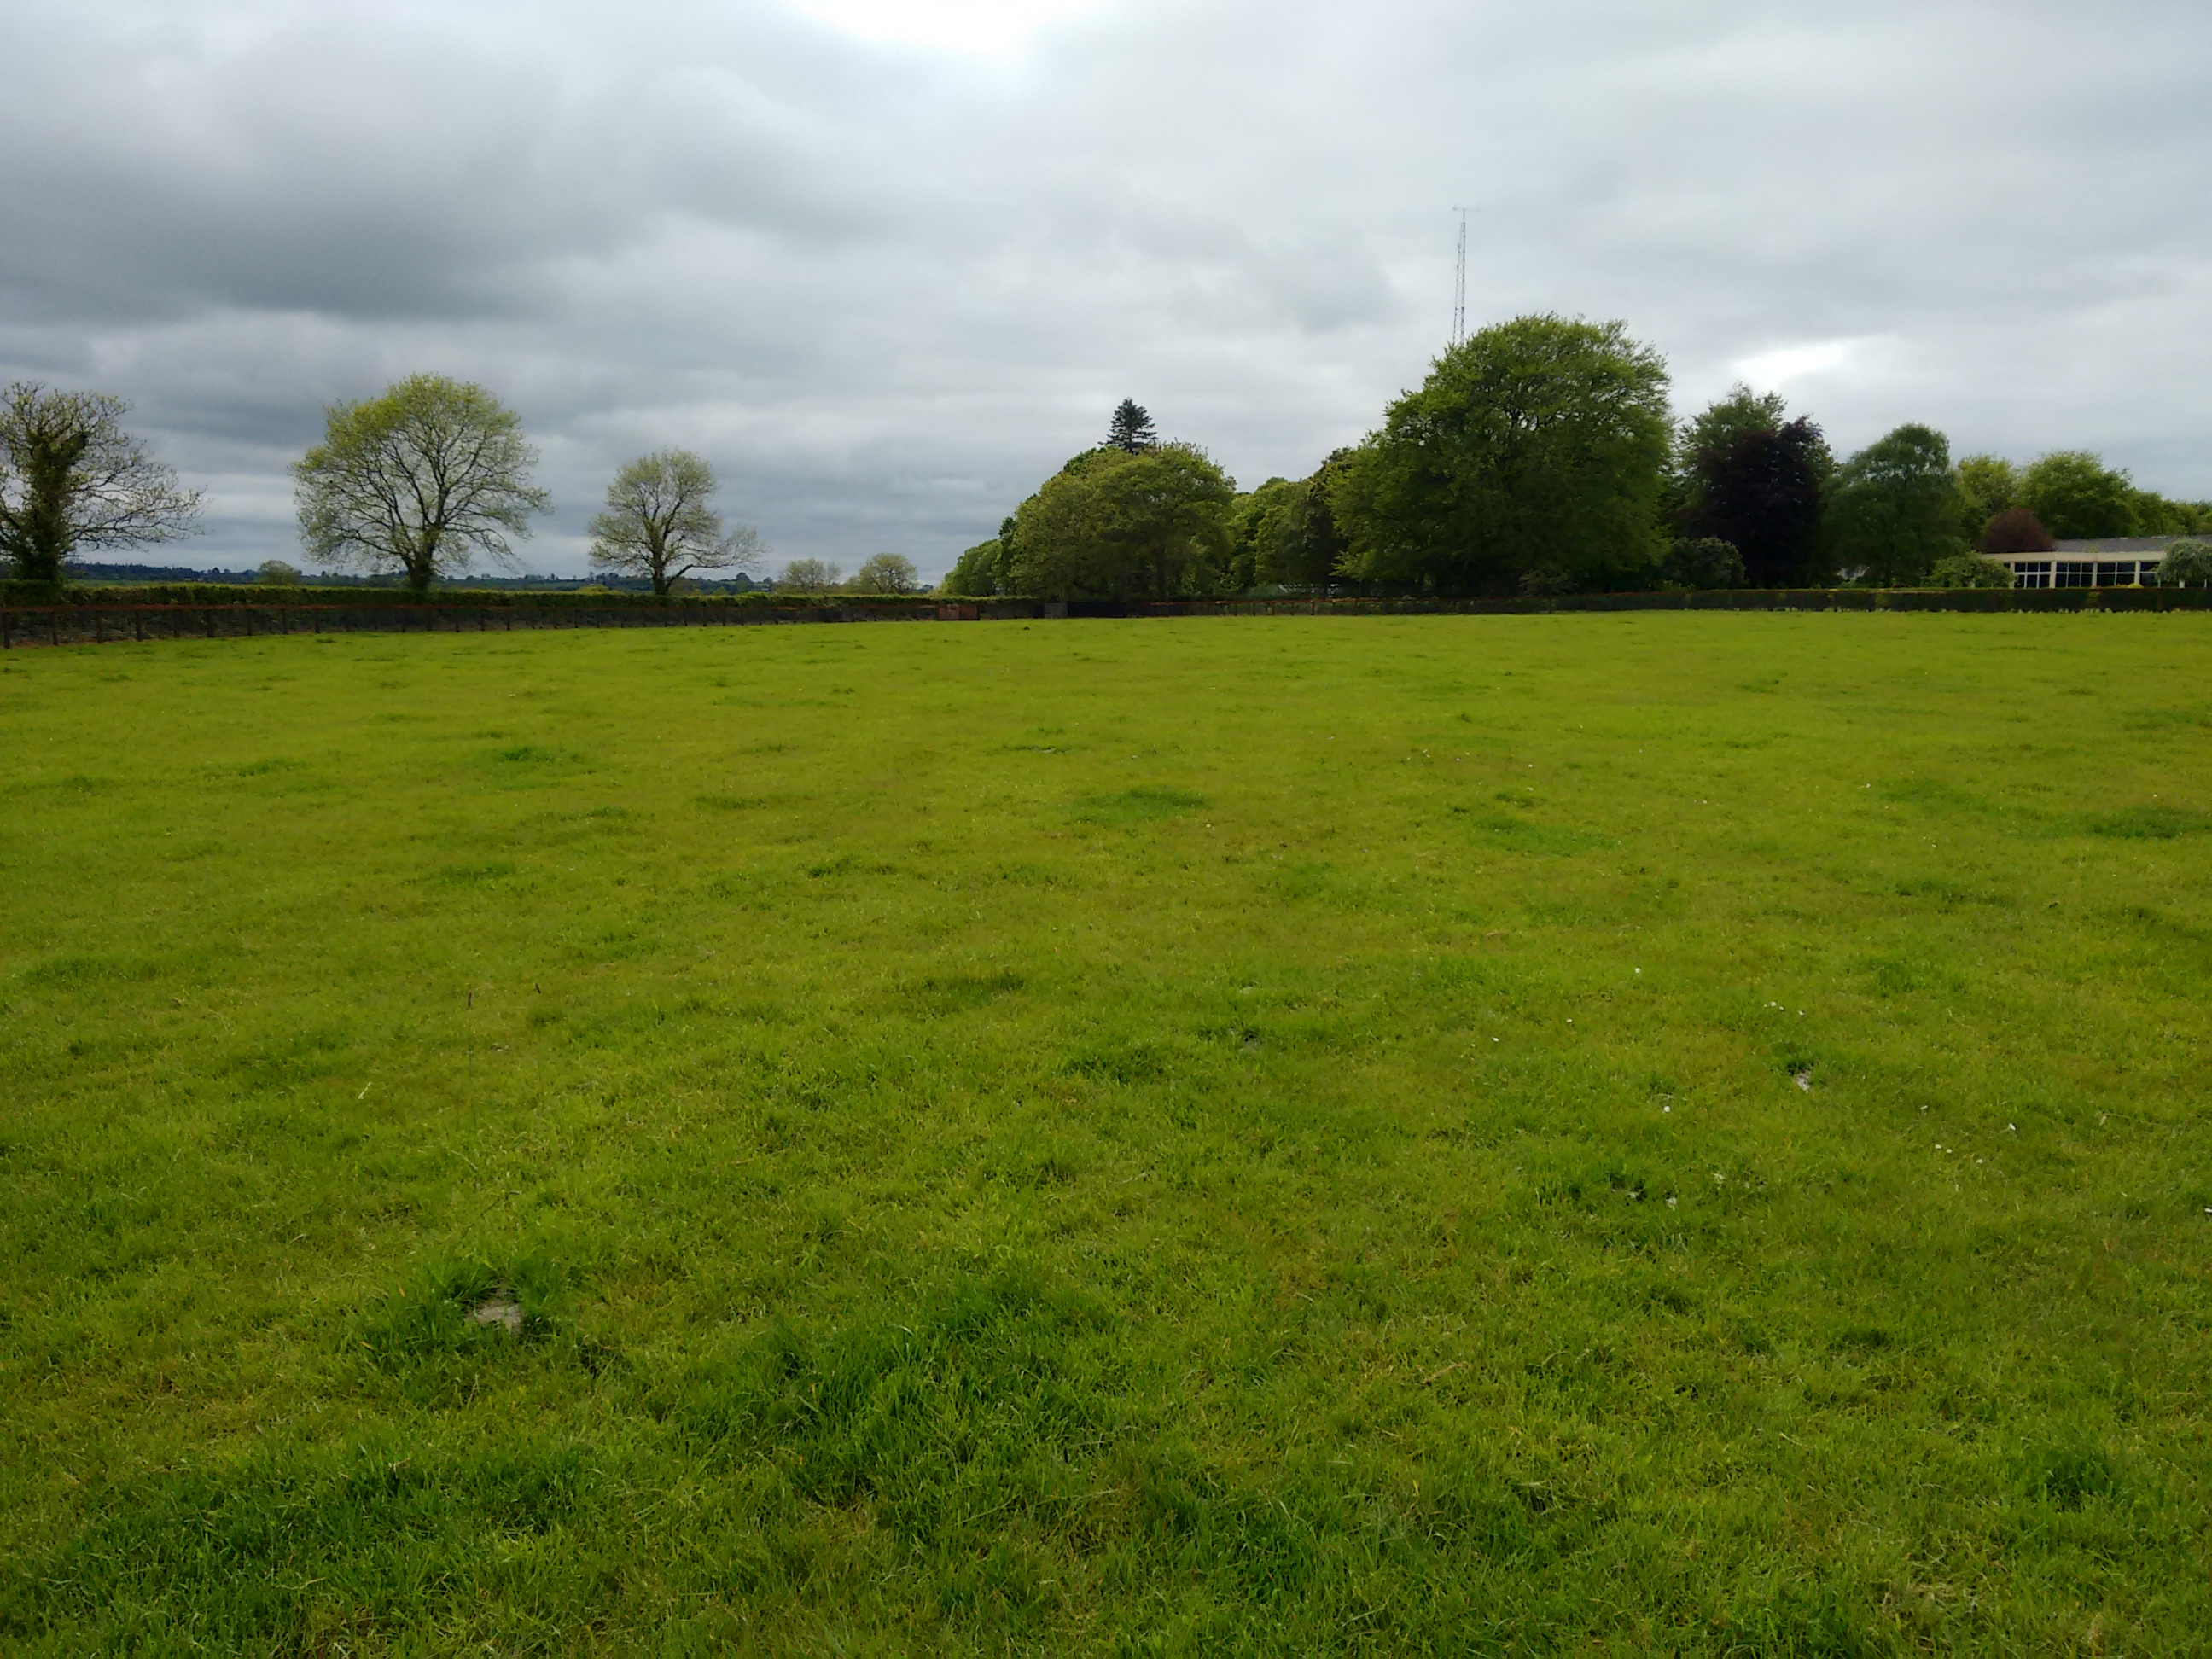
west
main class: Grassland
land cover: Grassland without tree/shrub cover
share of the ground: > 75 %
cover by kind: herbaceous plants 95 %, unconsolidated bare surface 5 %
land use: Agriculture (excluding fallow land and kitchen gardens)
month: May
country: IE
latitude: 53.4251
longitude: -6.7016
